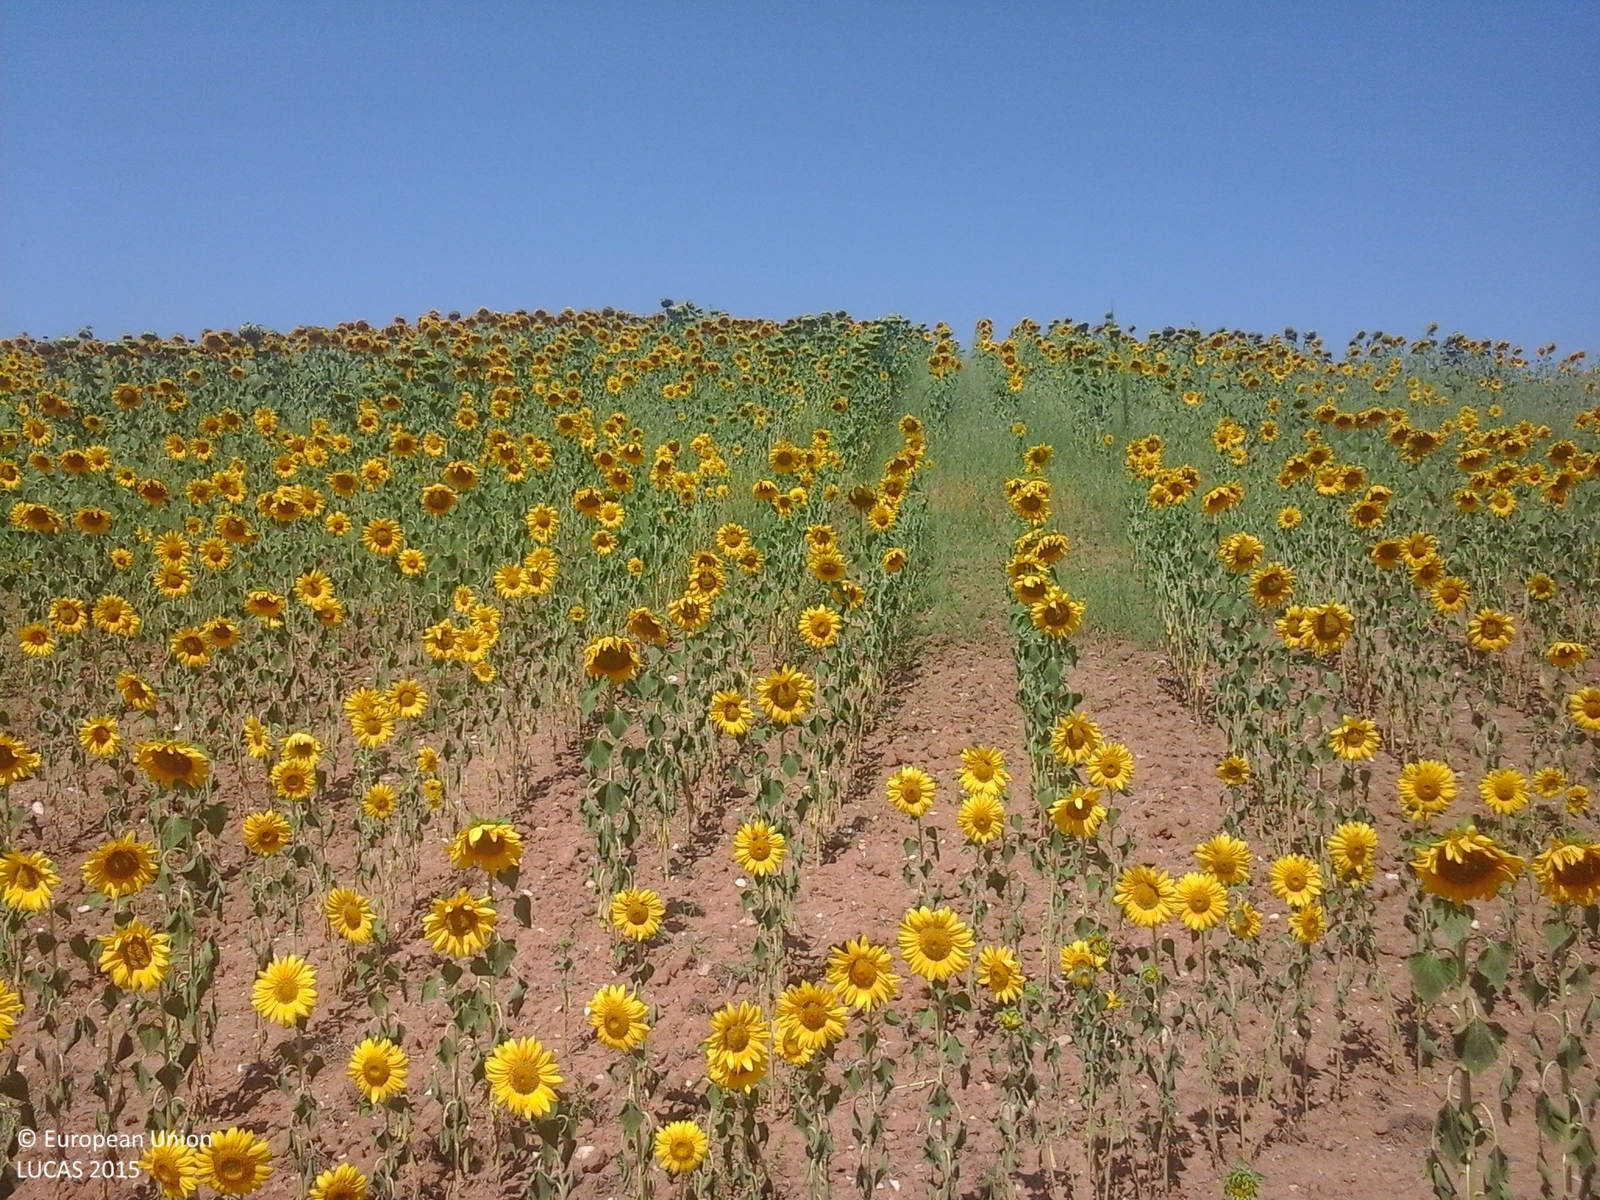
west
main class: Shrubland
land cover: Shrubland without tree cover
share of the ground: > 75 %
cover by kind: shrubs 75 %, herbaceous plants 25 %
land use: Semi-natural and natural areas not in use
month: July
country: GR
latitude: 40.6171
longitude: 23.1895
